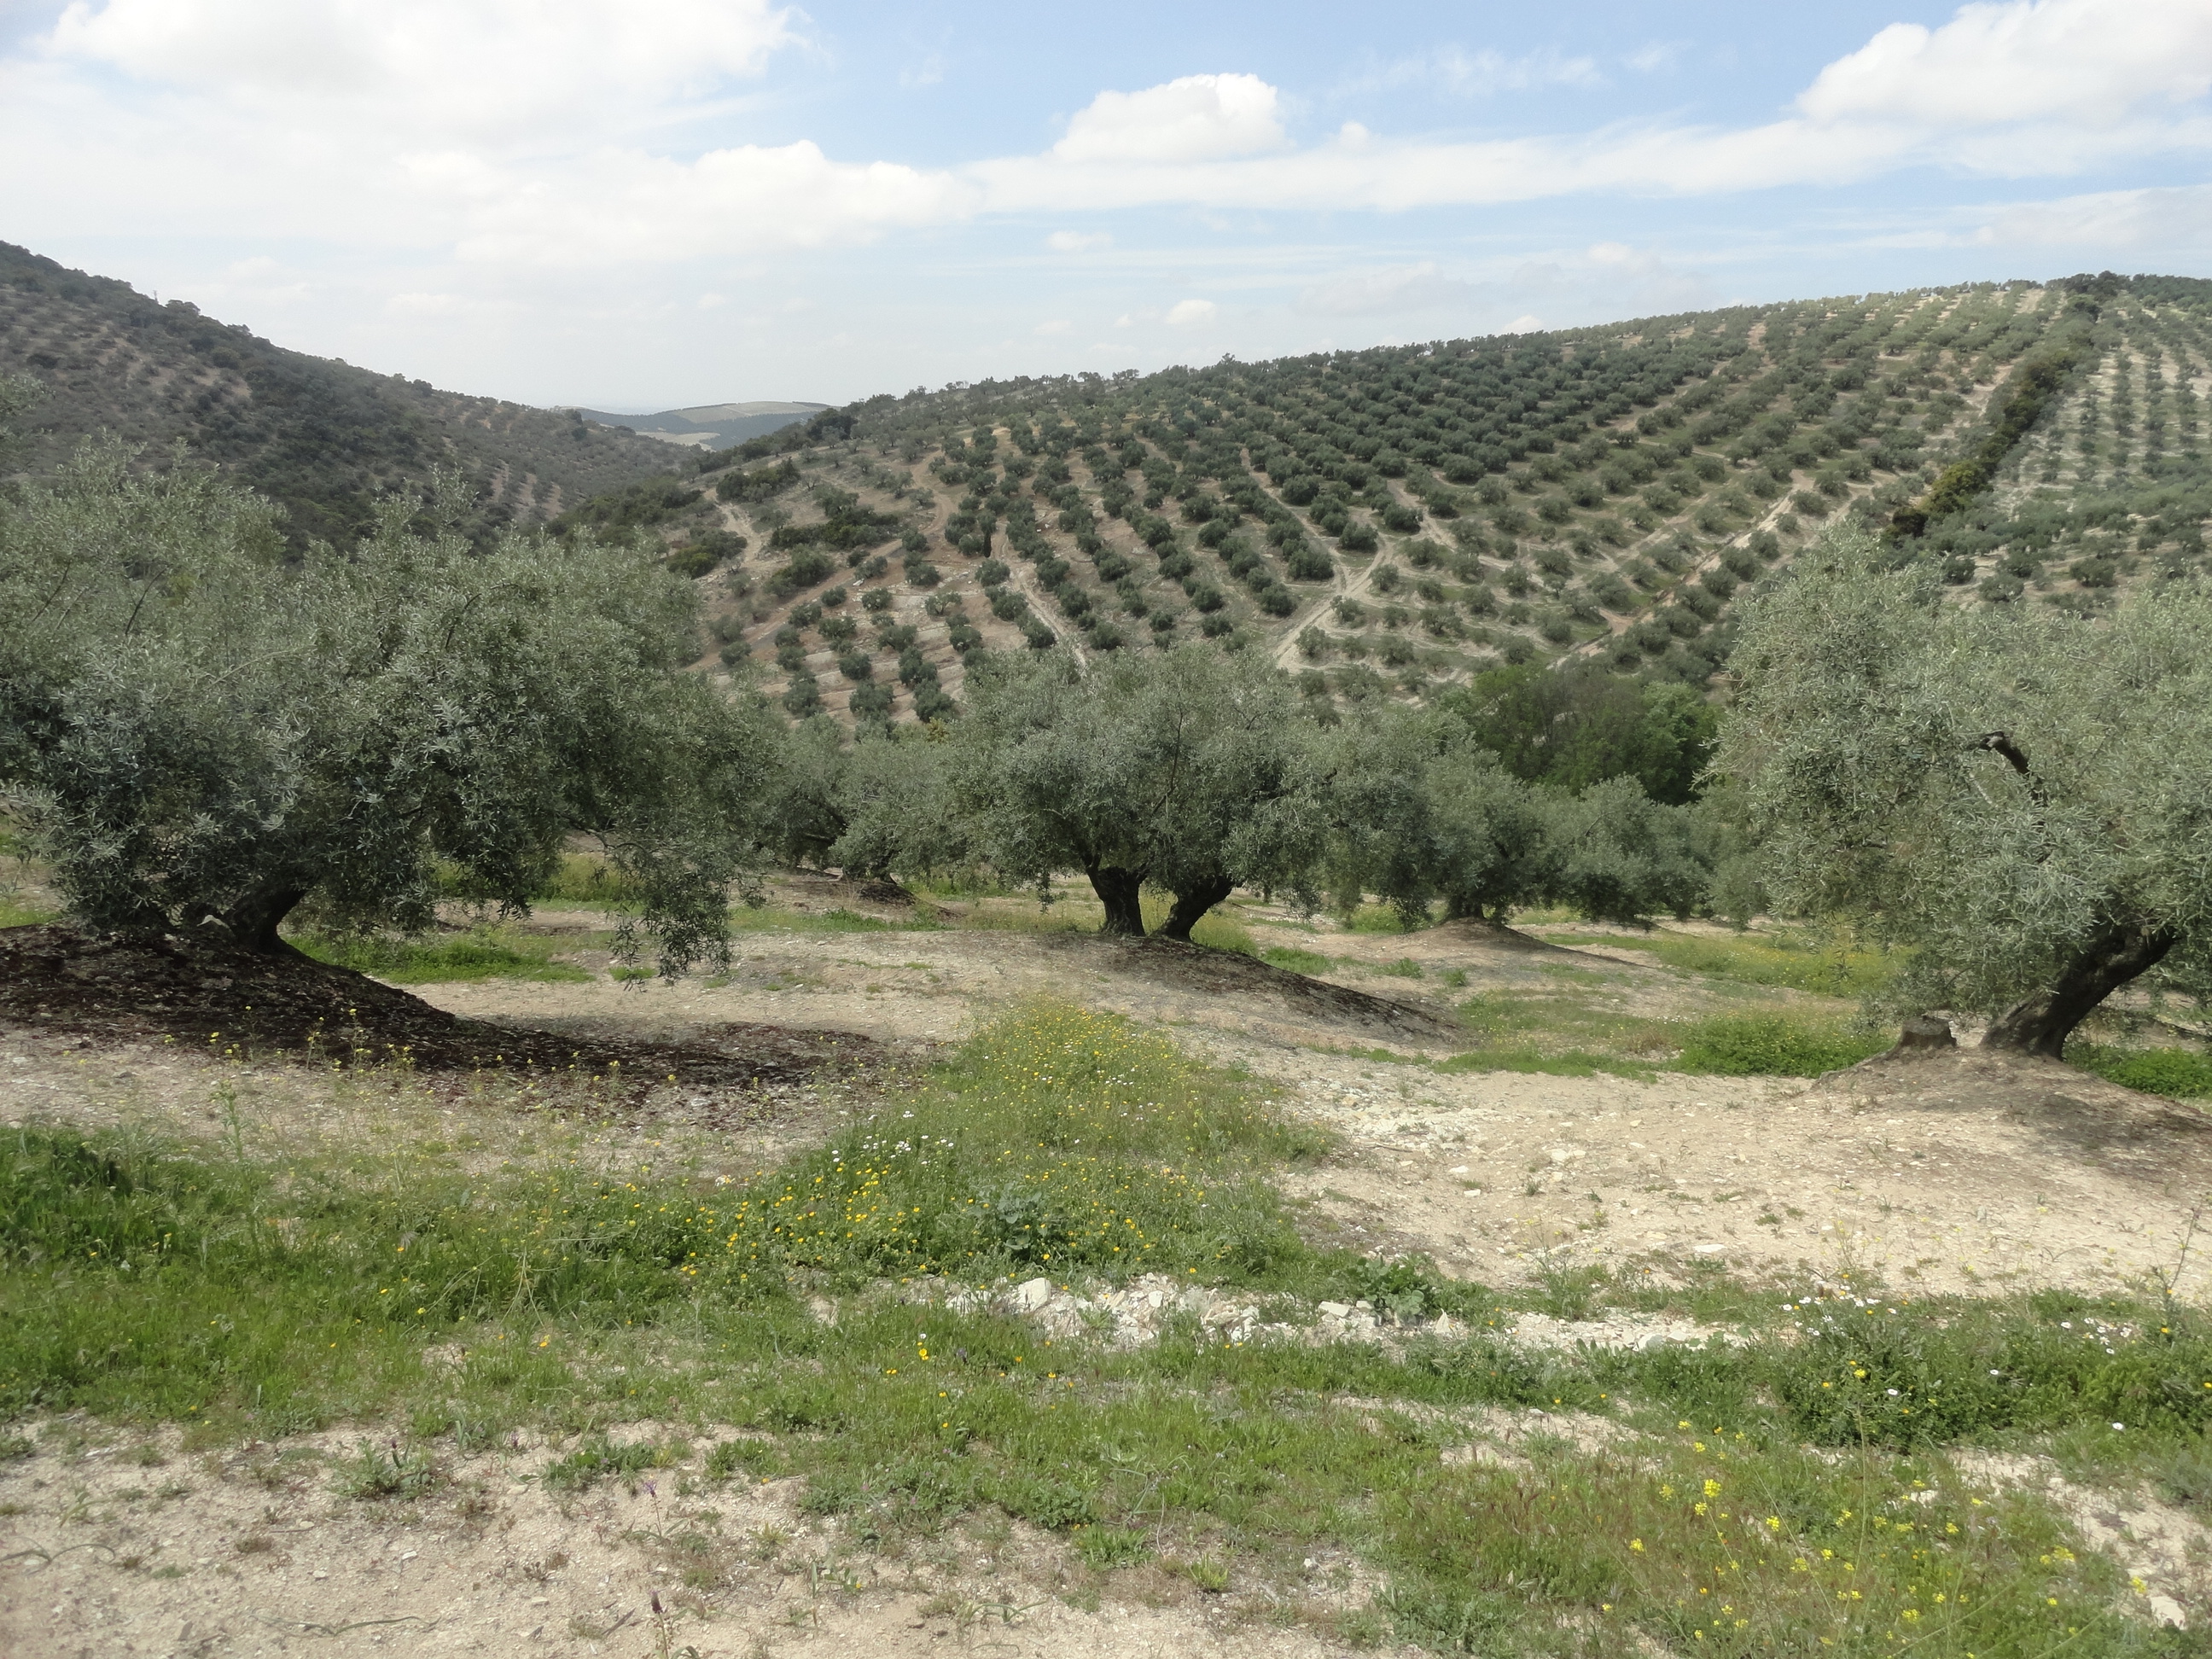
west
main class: Cropland
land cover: Olive groves
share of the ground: 50 - 75 %
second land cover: Spontaneously vegetated surfaces
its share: 10 - 25 %
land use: Agriculture (excluding fallow land and kitchen gardens)
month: April
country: ES
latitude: 37.5628
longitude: -4.5306
